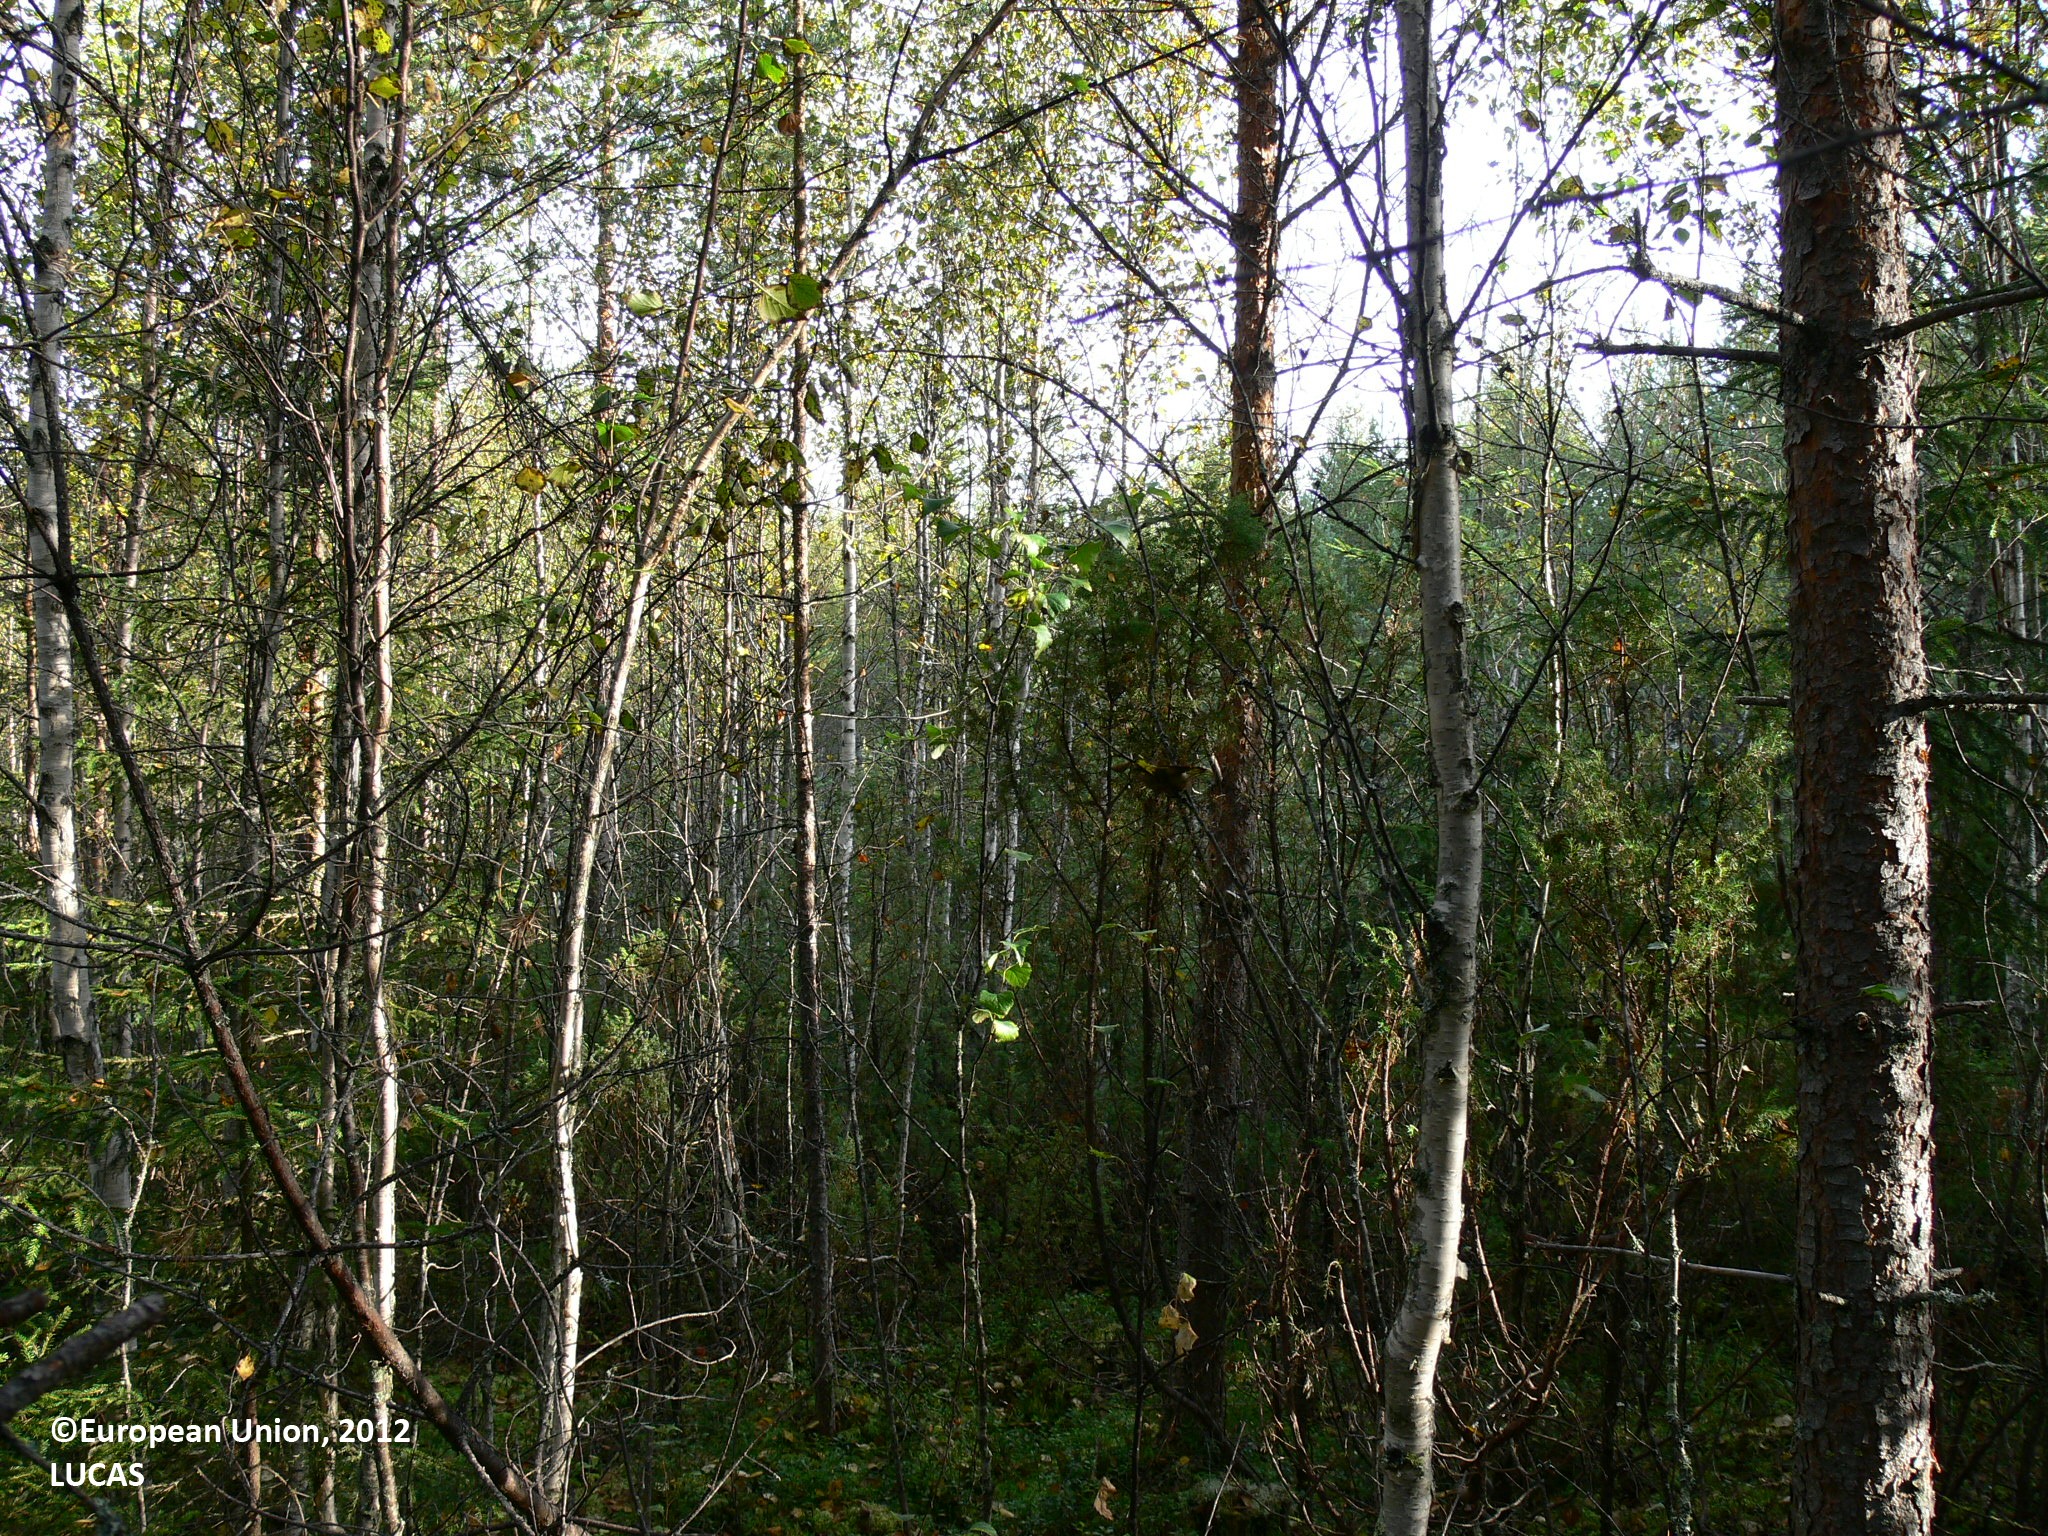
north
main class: Woodland
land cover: Other mixed woodland
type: boreal forest
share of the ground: > 75 %
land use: Forestry
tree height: > 5 m
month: September
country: FI
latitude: 63.2380
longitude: 30.1018
